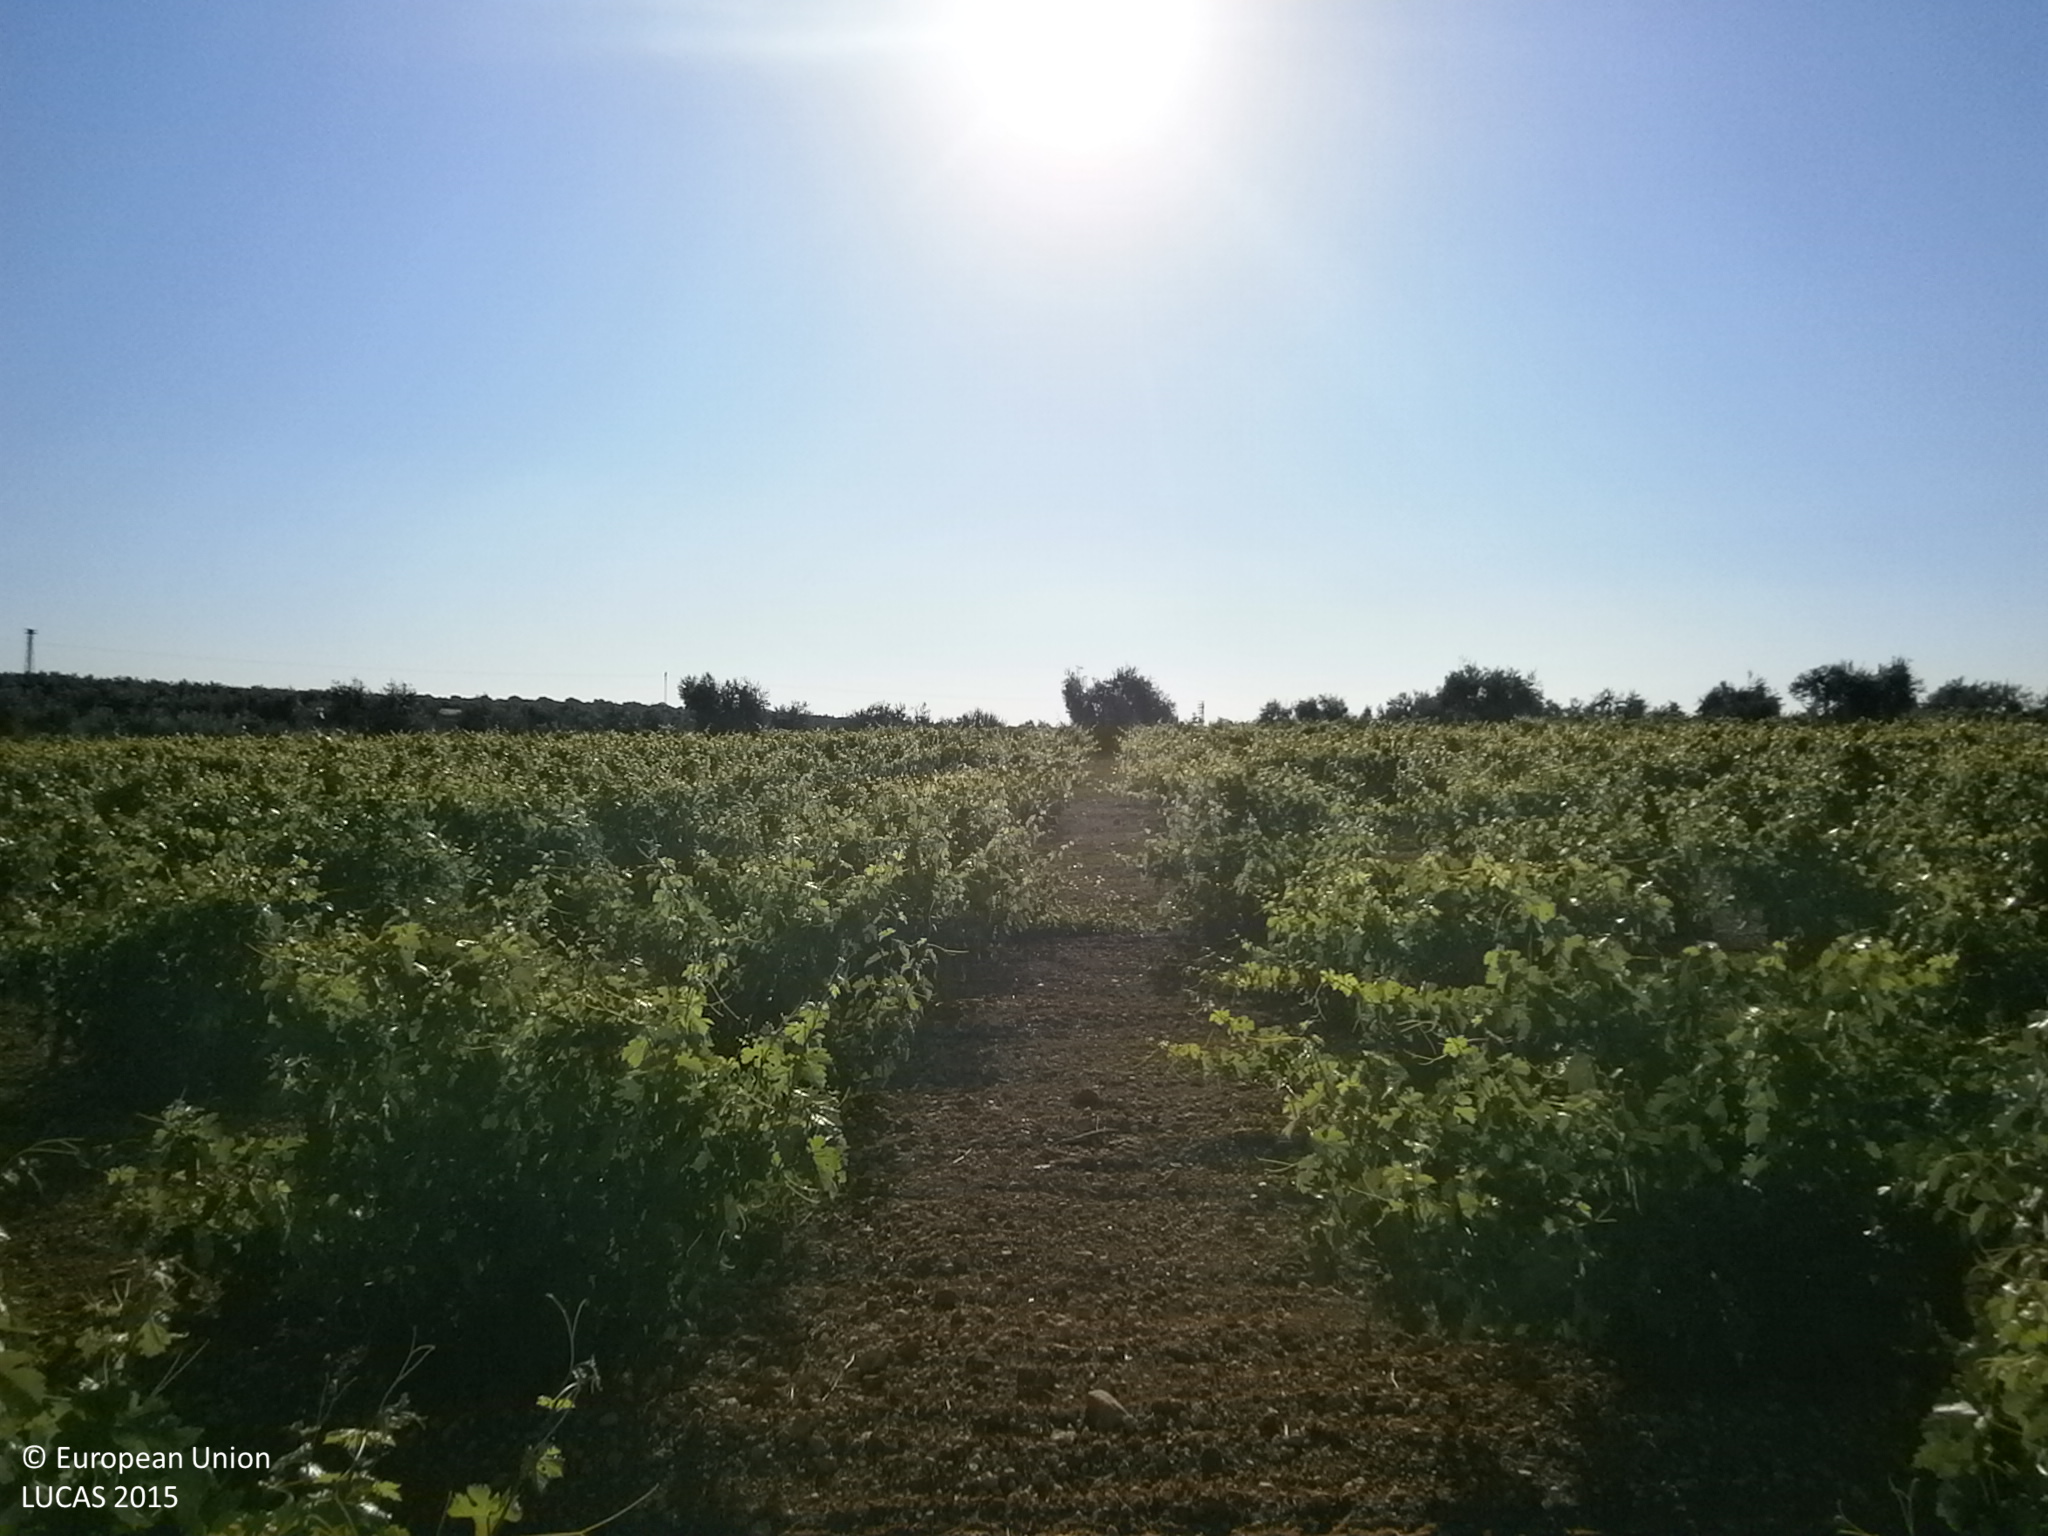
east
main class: Cropland
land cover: Vineyards
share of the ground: 25 - 50 %
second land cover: Other bare soil
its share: > 75 %
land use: Agriculture (excluding fallow land and kitchen gardens)
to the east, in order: Vineyards; Other bare soil; Olive groves; Grass margins; Vineyards
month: June
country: ES
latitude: 38.7214
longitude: -6.6574
